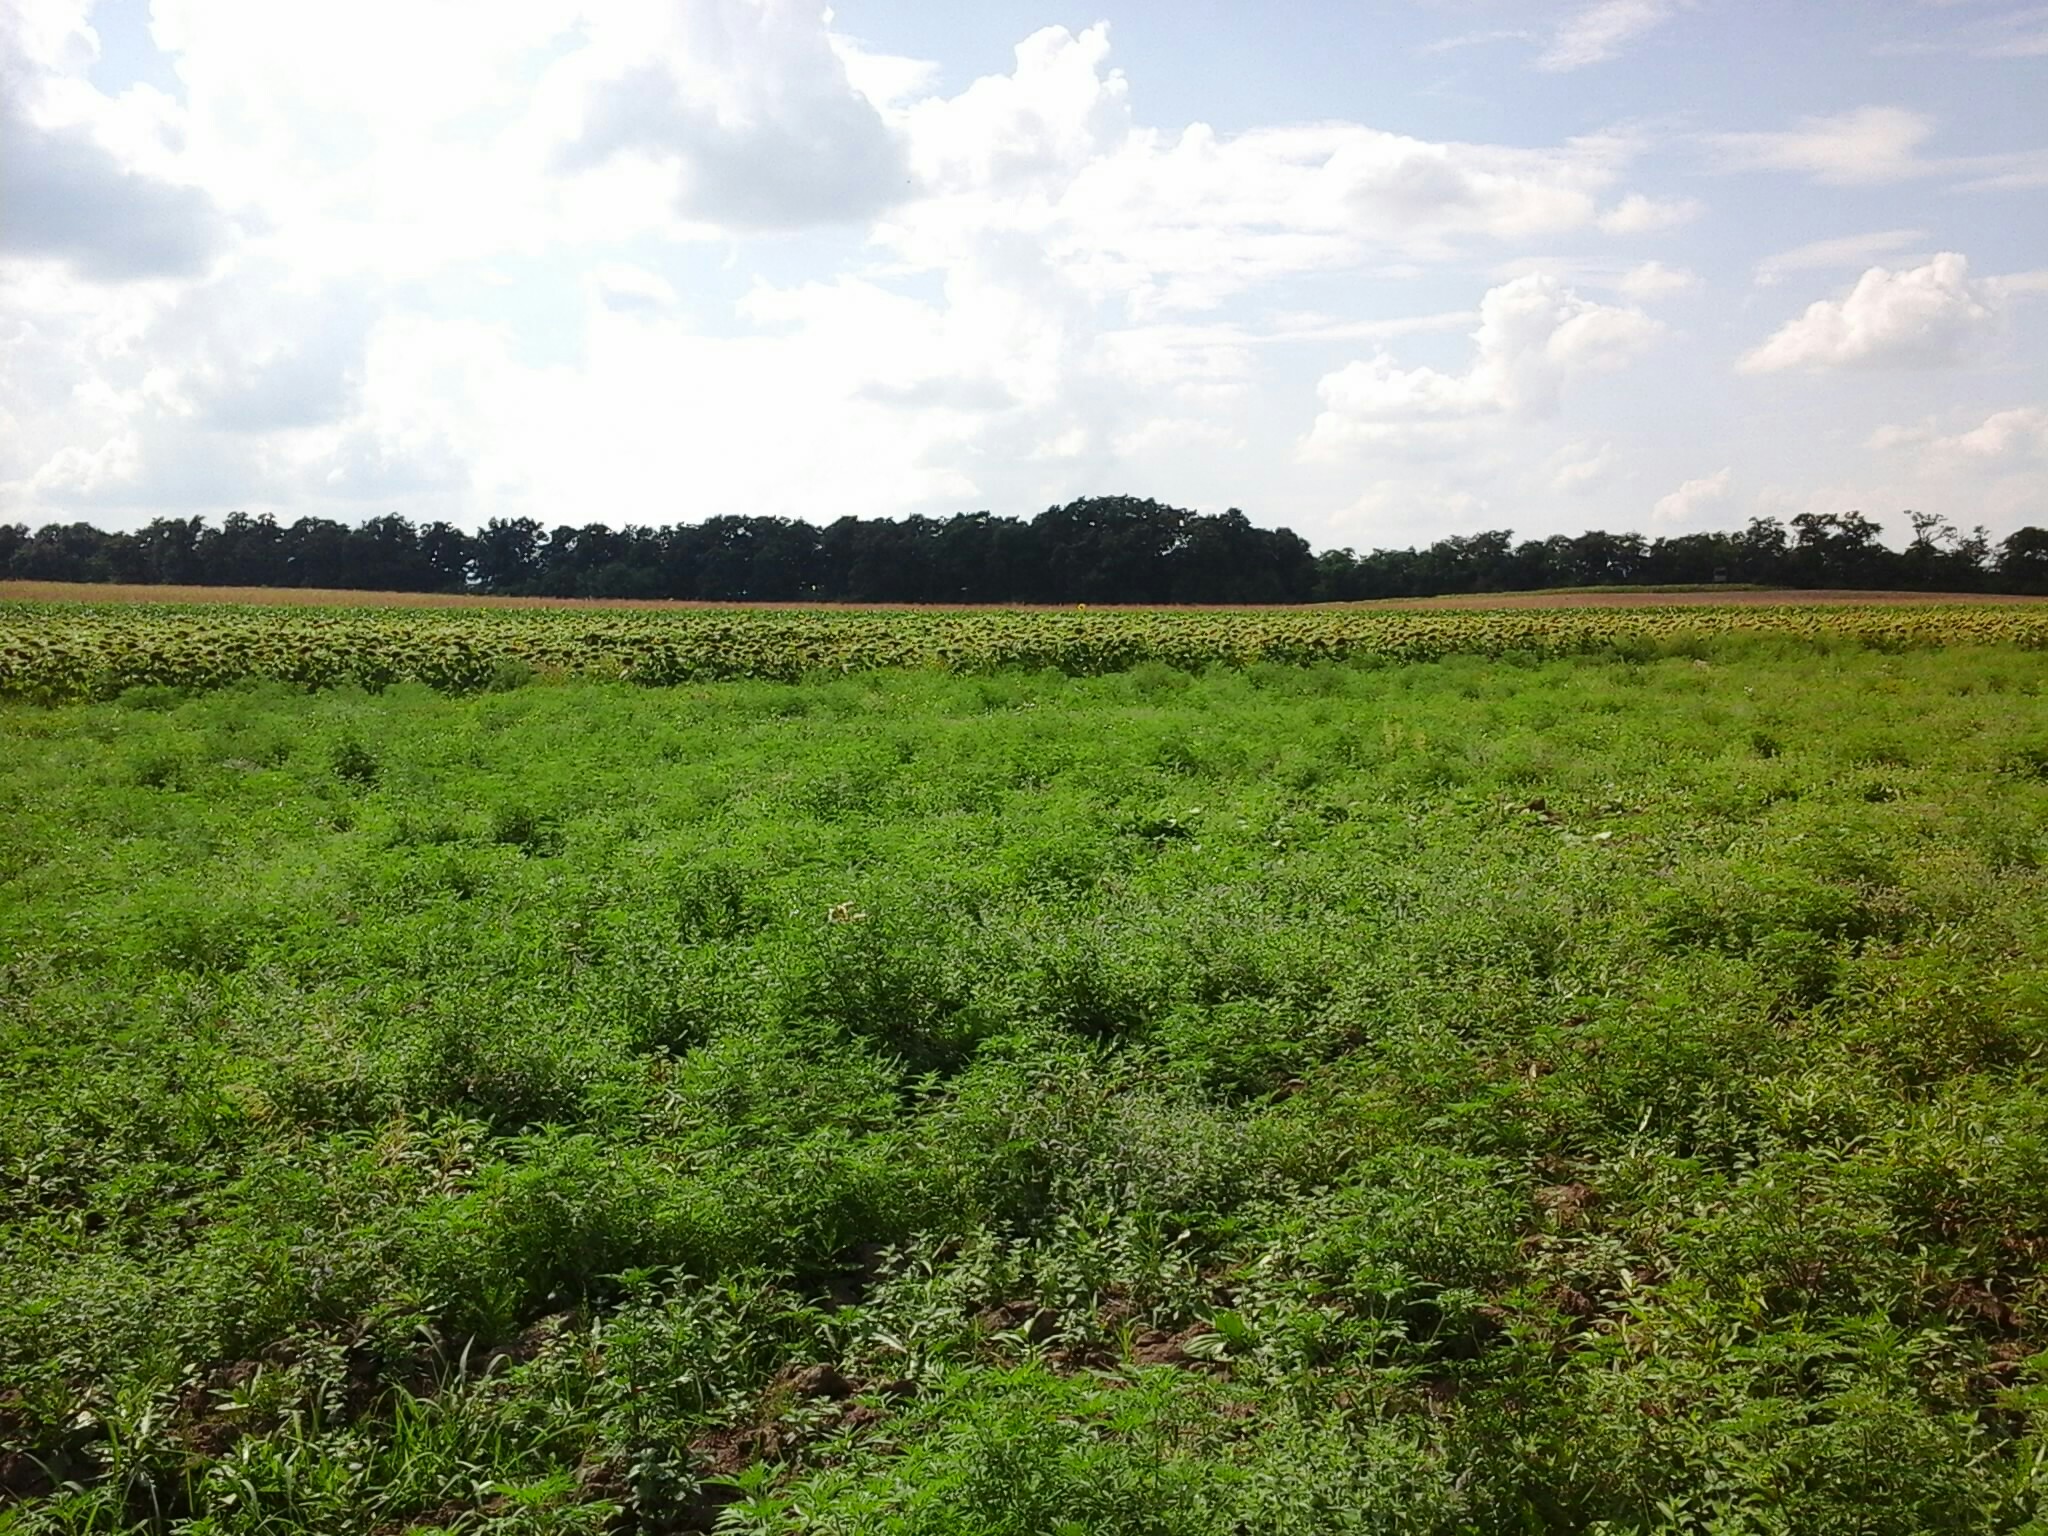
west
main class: Grassland
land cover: Spontaneously vegetated surfaces
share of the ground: > 75 %
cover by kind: herbaceous plants 100 %
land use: Fallow land
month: August
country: HU
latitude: 47.5015
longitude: 18.2030
